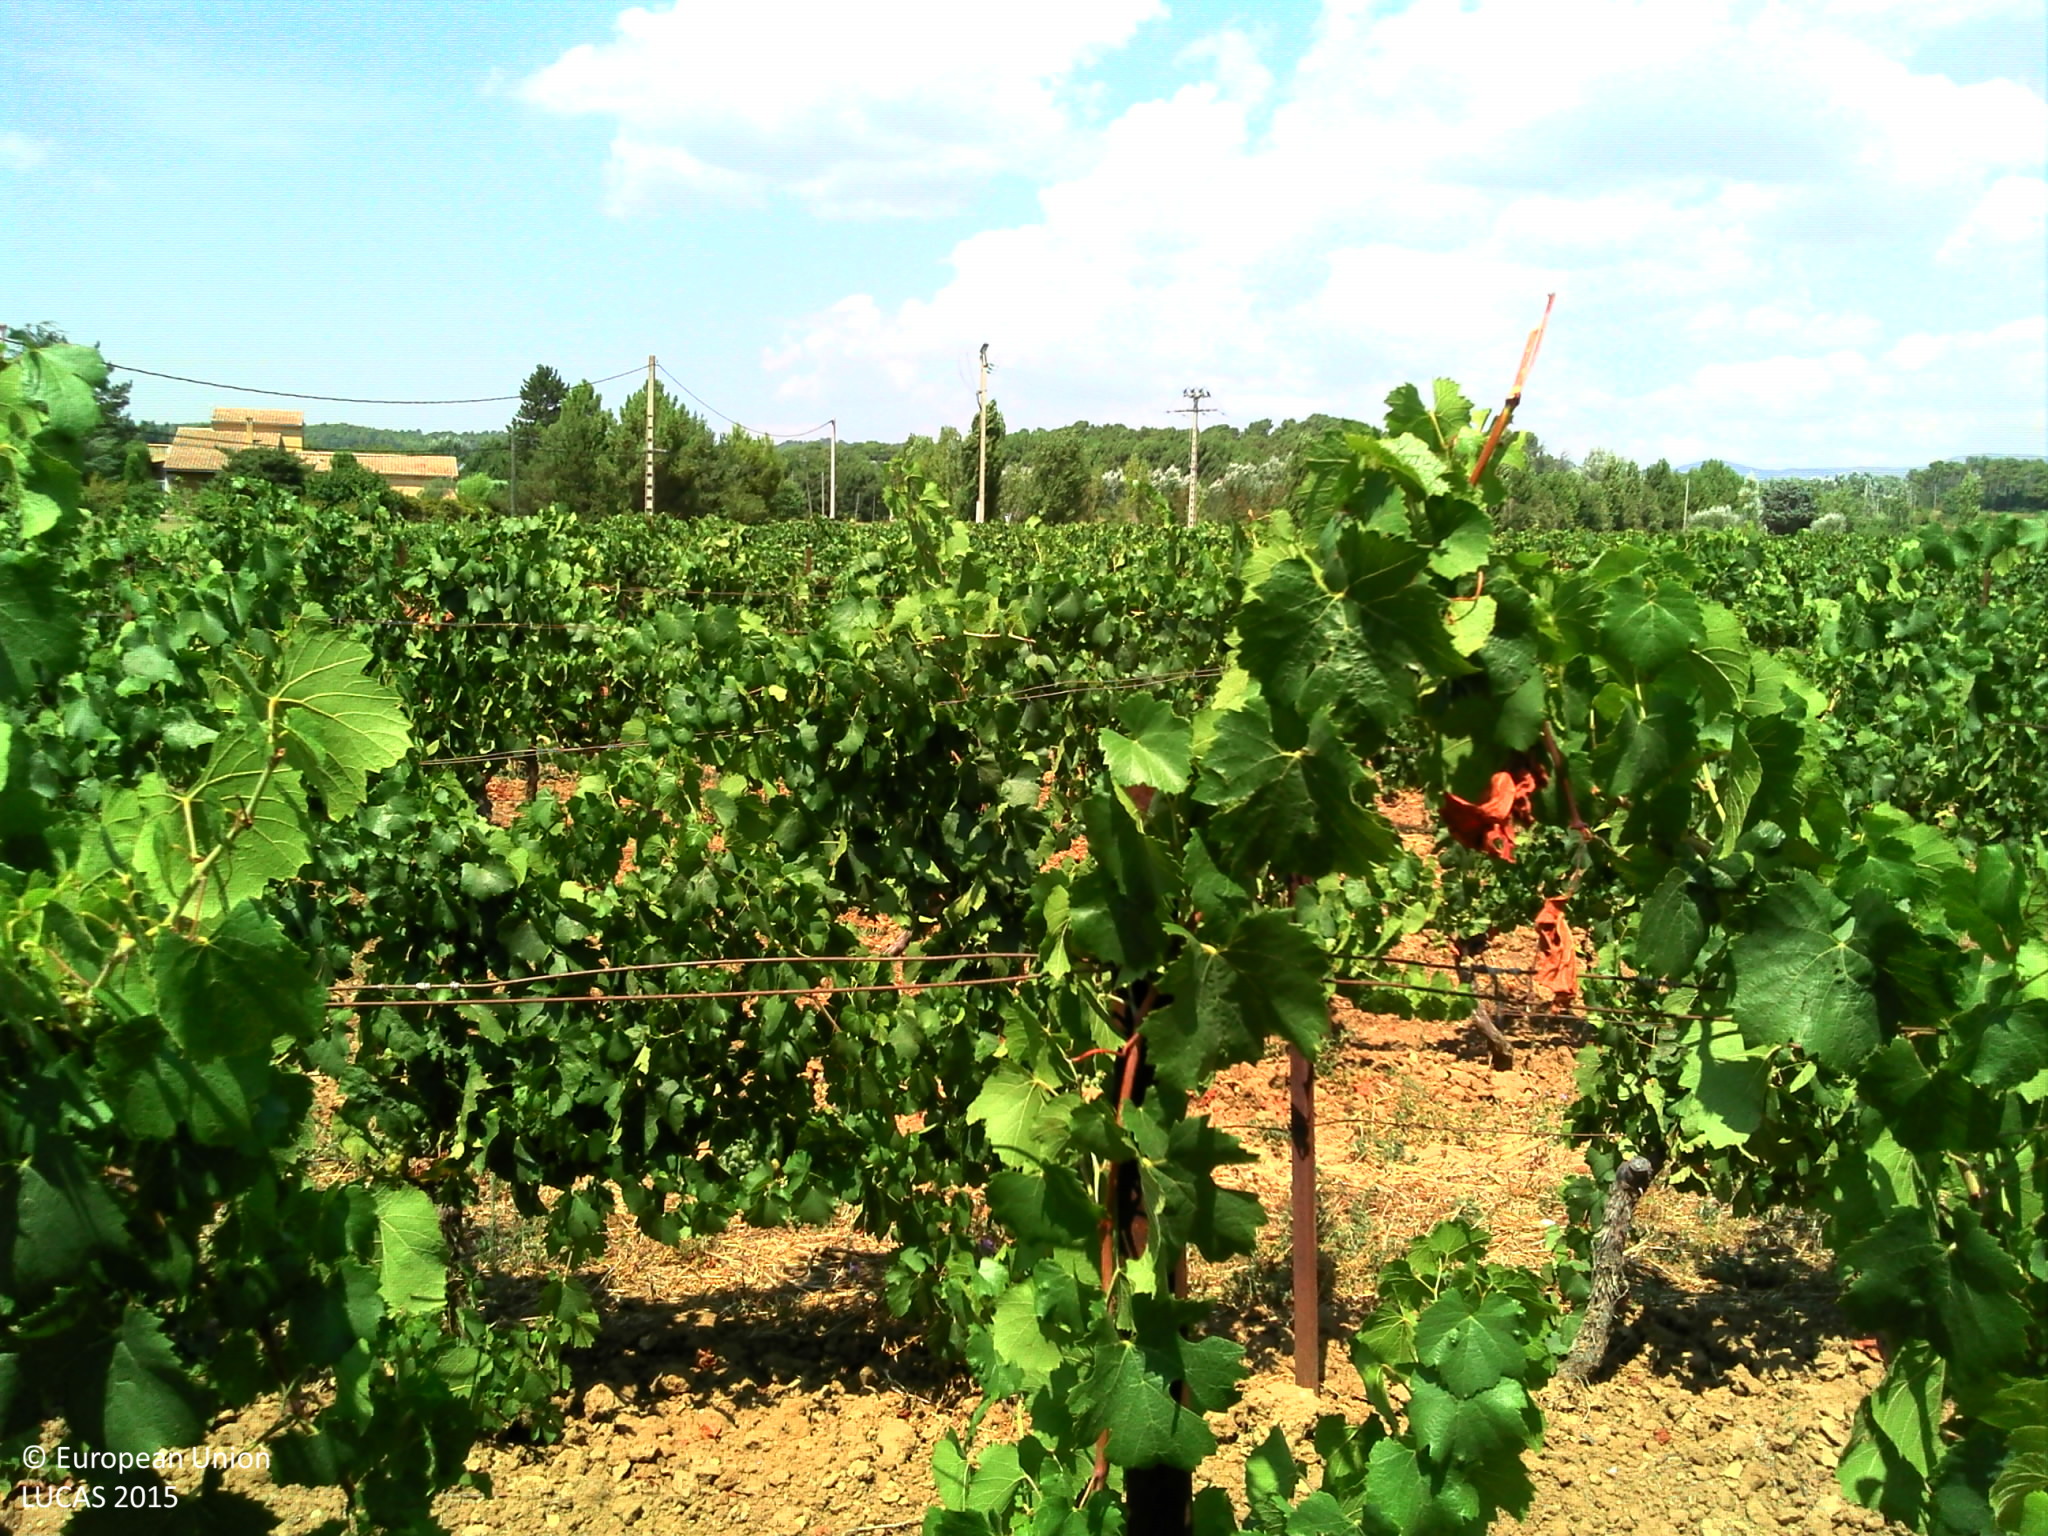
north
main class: Cropland
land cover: Vineyards
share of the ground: 25 - 50 %
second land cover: Other bare soil
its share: > 75 %
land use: Agriculture (excluding fallow land and kitchen gardens)
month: August
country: FR
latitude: 43.8644
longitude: 5.2930
